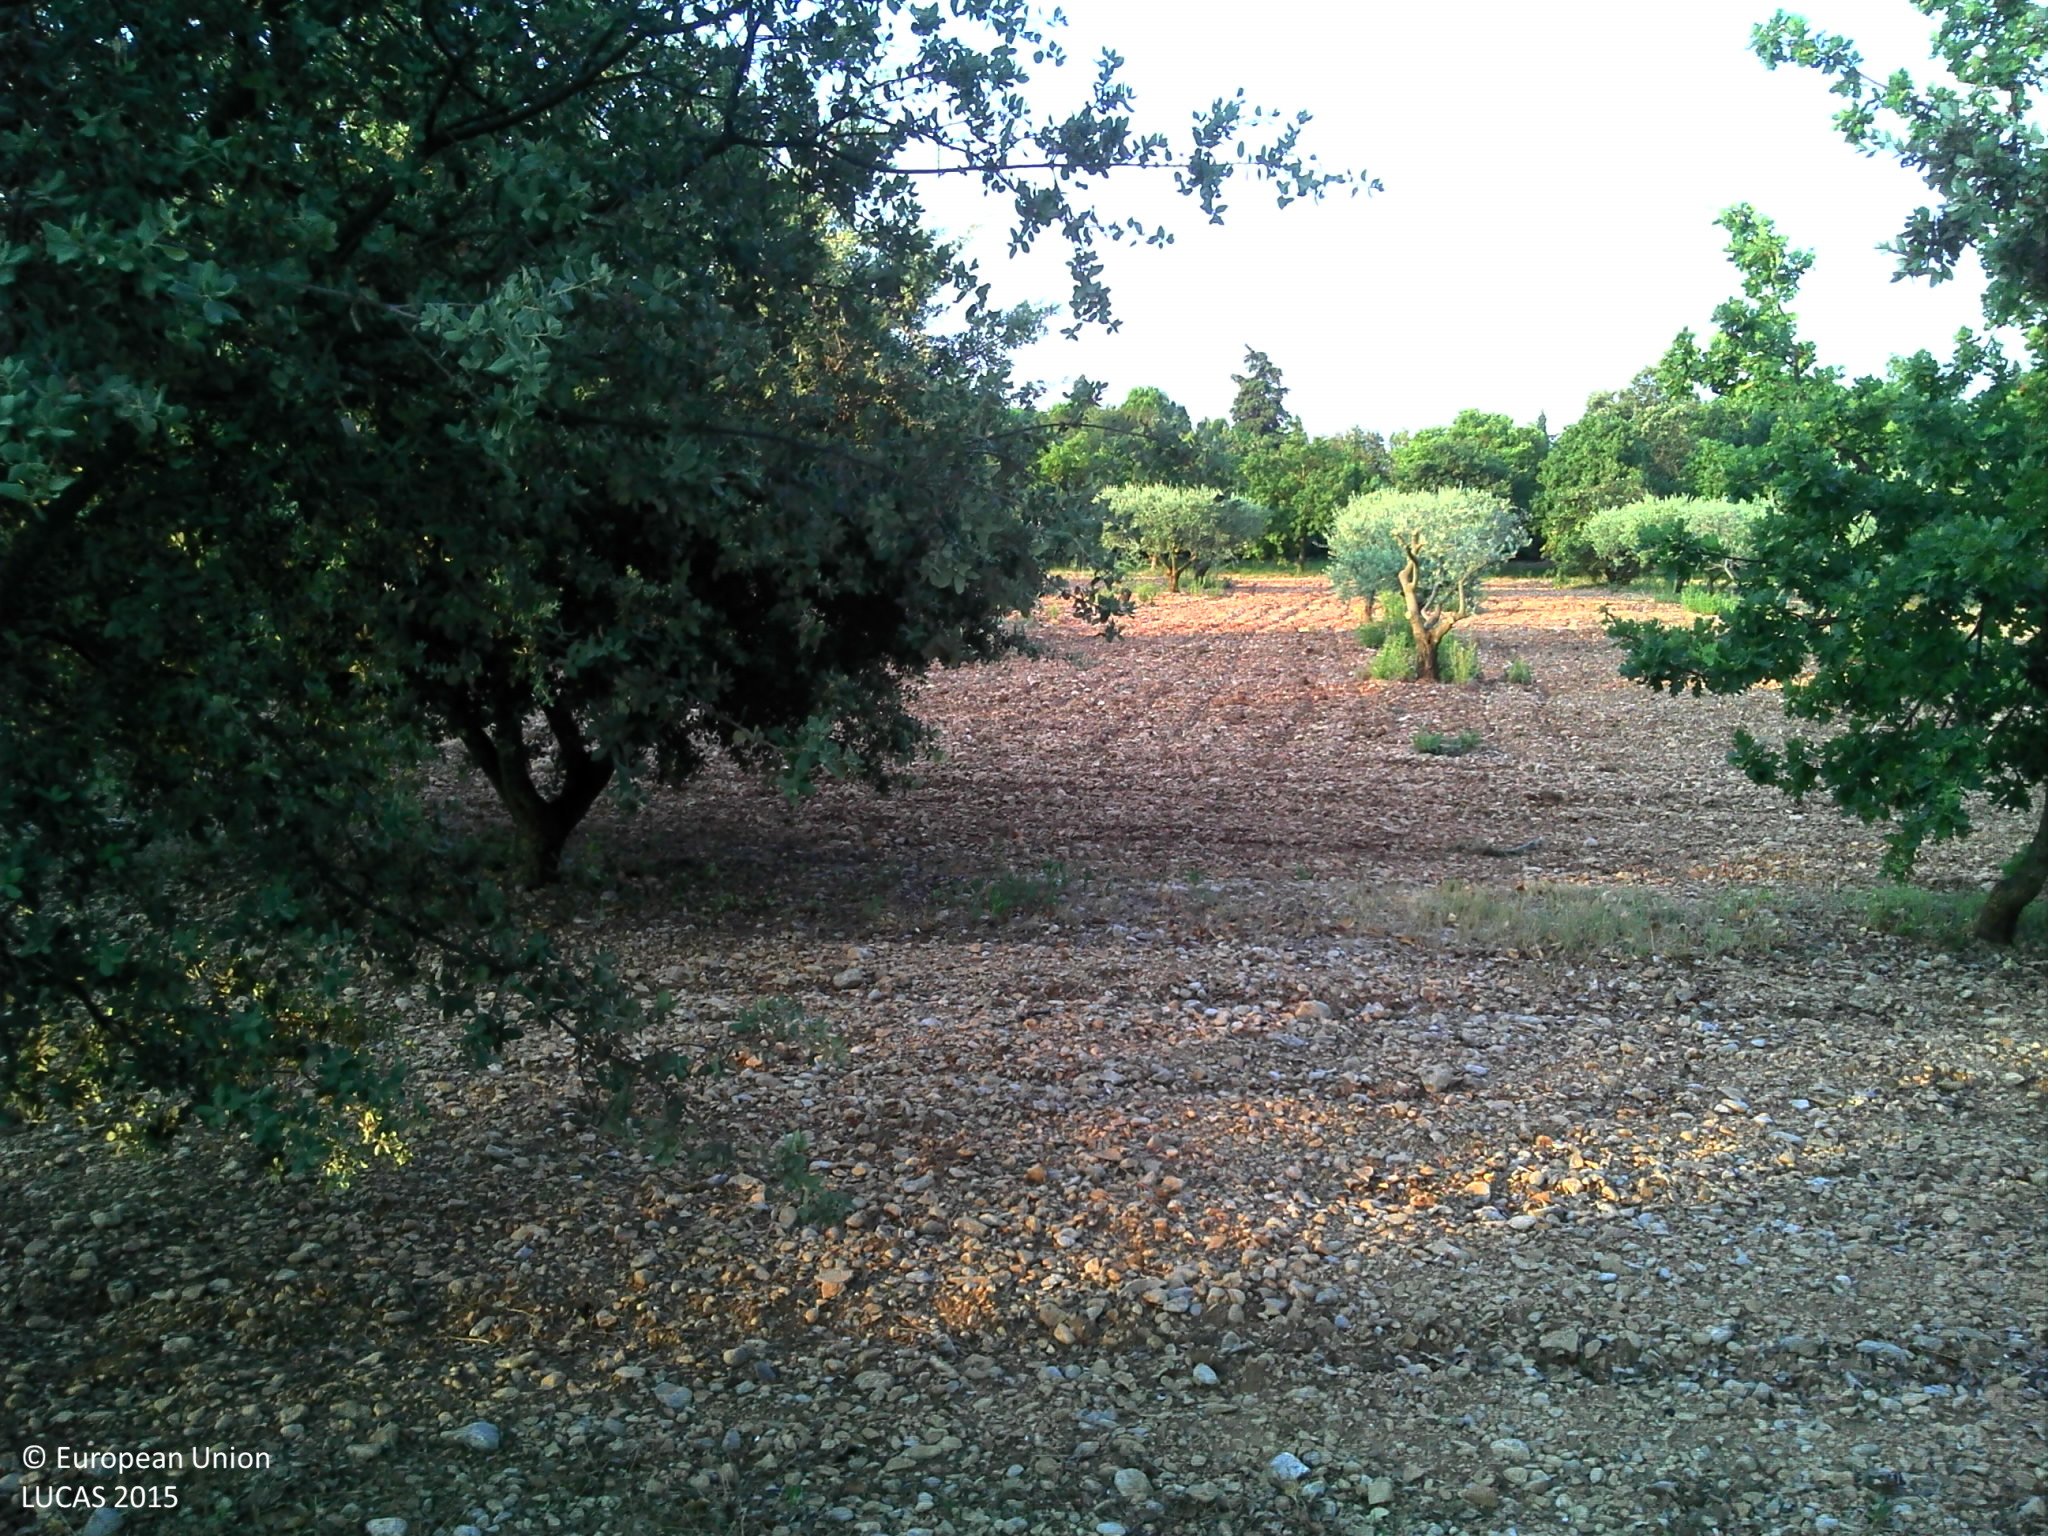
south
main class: Cropland
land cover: Pear fruit
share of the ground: 25 - 50 %
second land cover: Other bare soil
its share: > 75 %
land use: Agriculture (excluding fallow land and kitchen gardens)
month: July
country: FR
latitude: 44.0159
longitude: 5.0561
